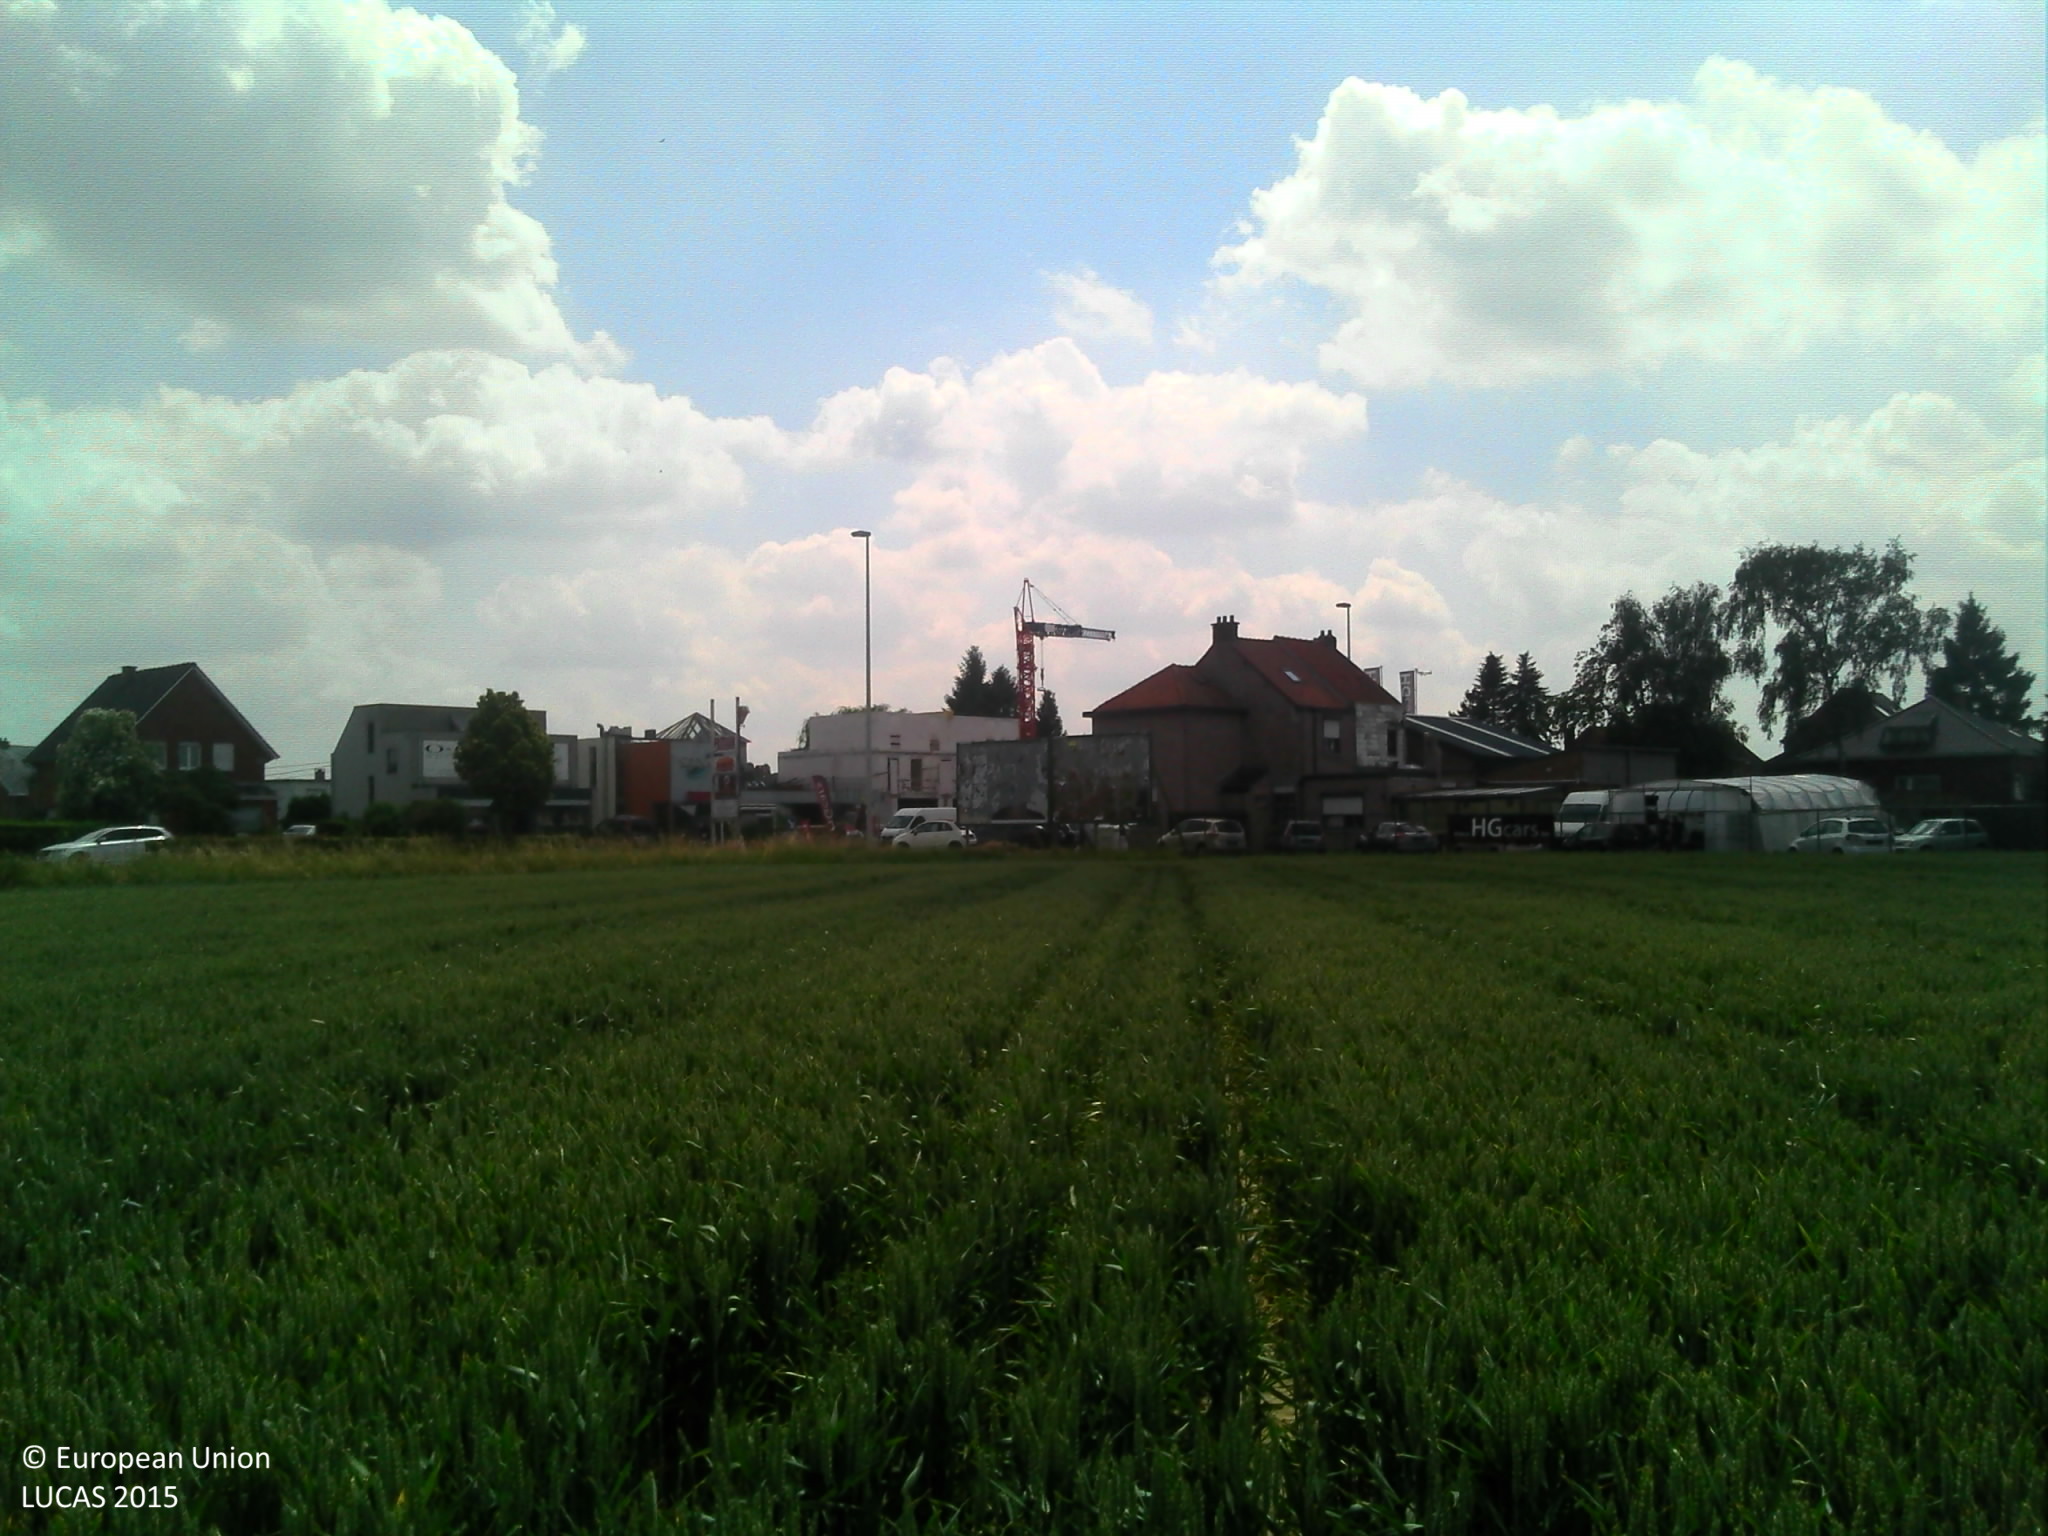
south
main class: Cropland
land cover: Common wheat
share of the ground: > 75 %
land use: Agriculture (excluding fallow land and kitchen gardens)
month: June
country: BE
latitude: 50.9368
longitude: 4.5457
